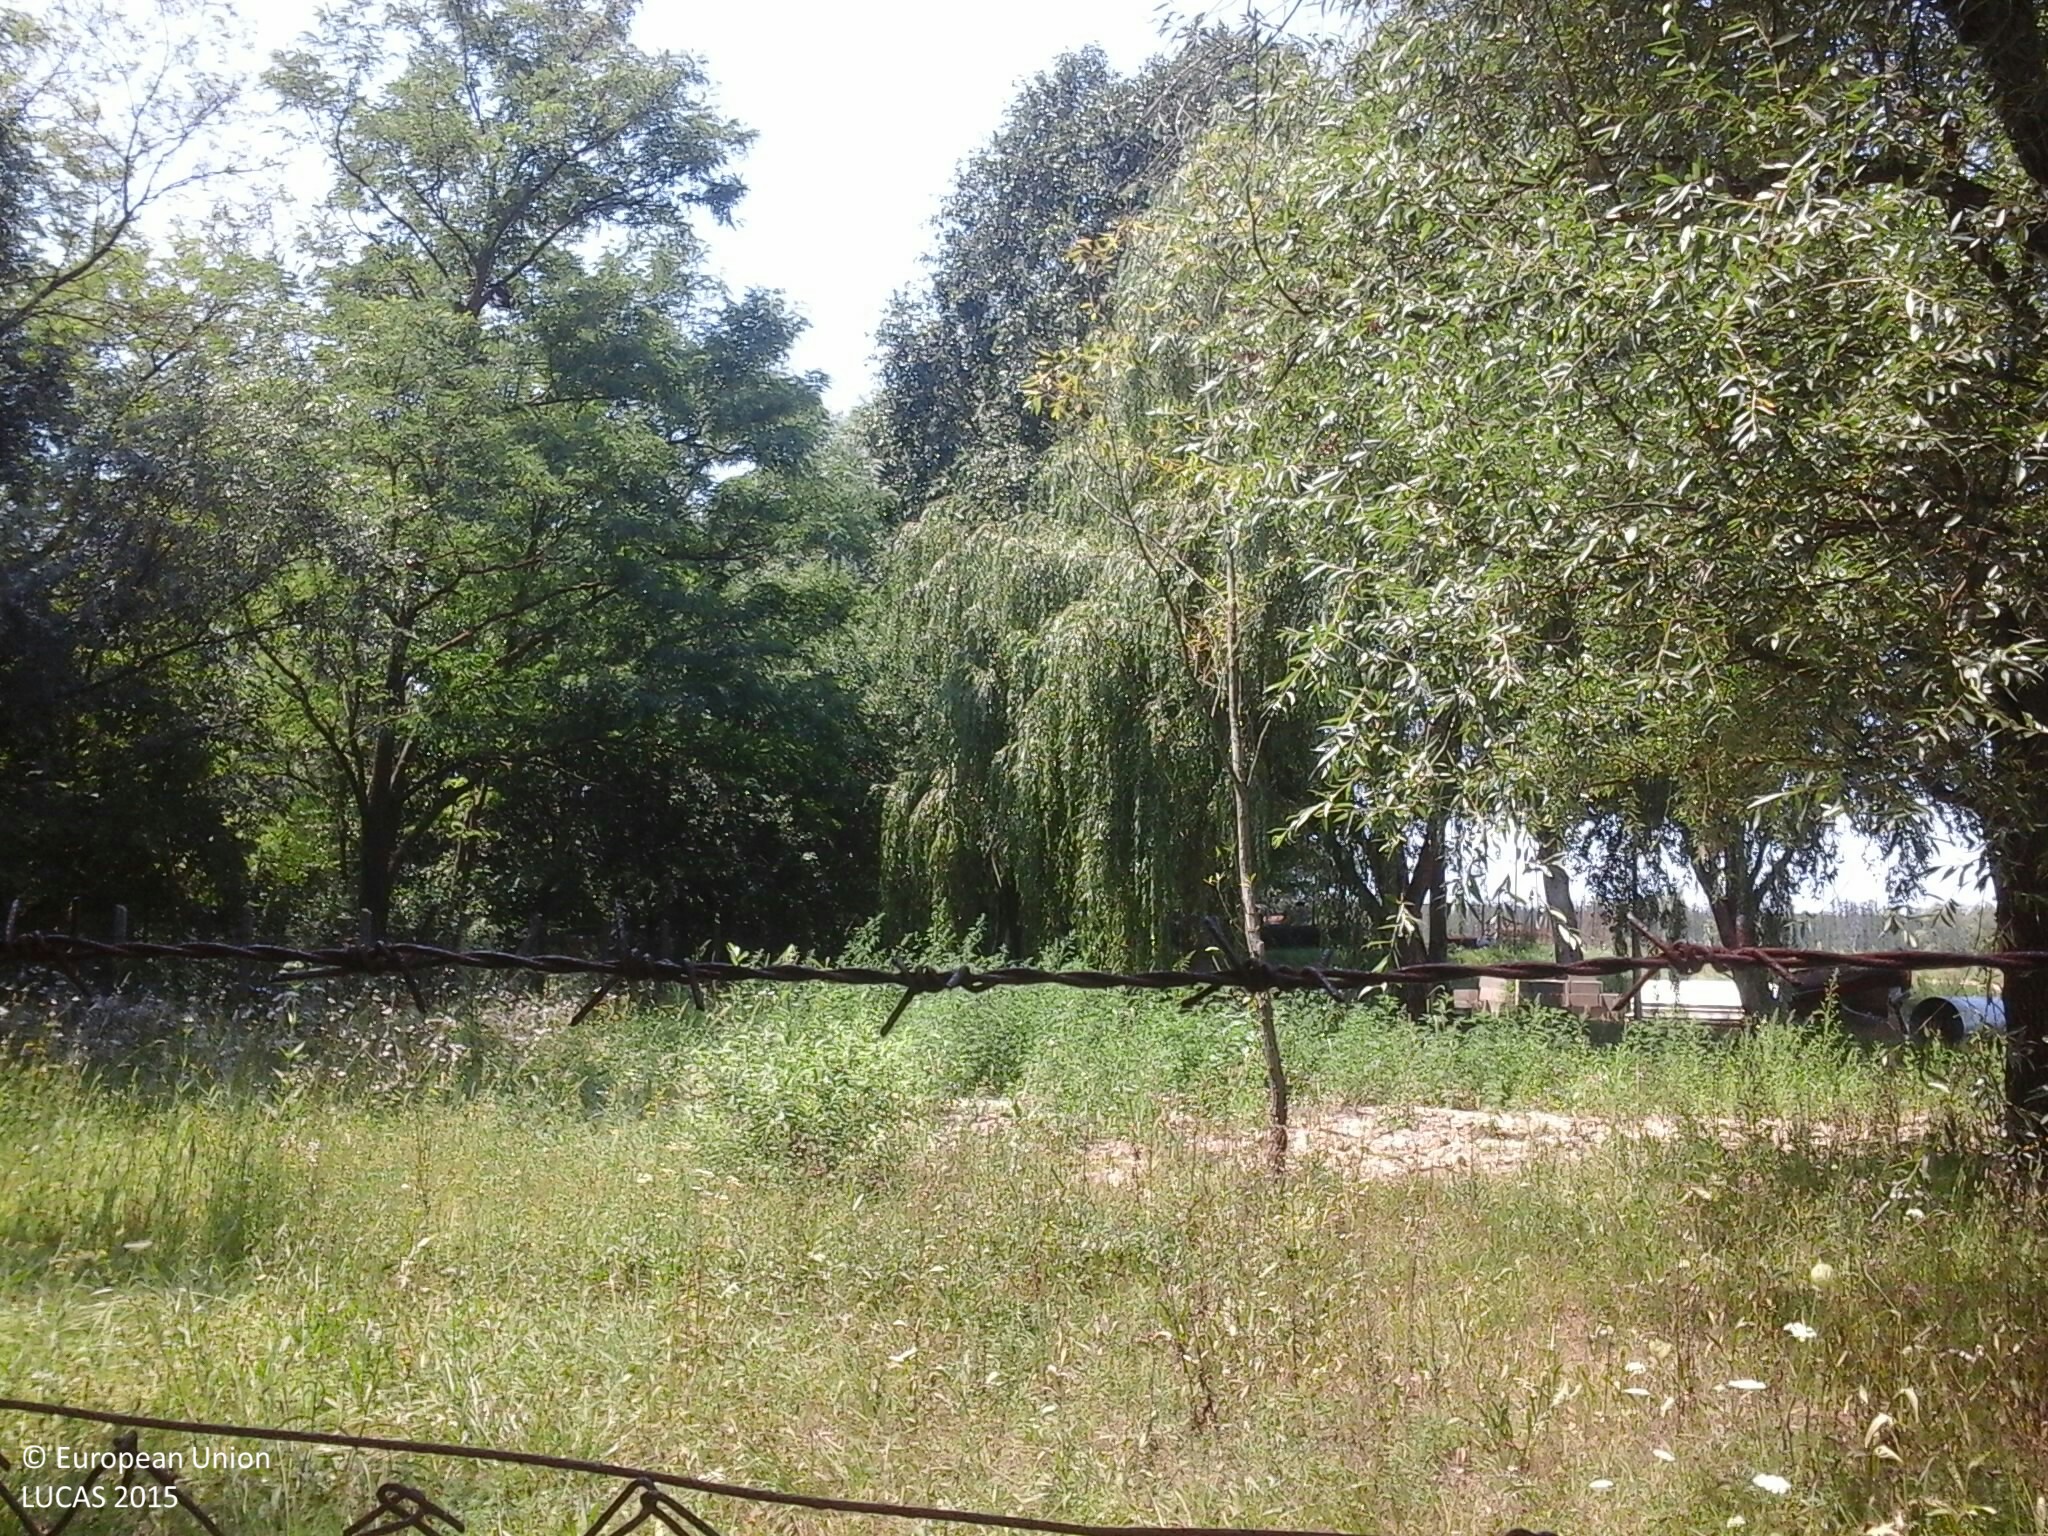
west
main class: Woodland
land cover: Broadleaved woodland
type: mesophytic deciduous forest
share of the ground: 50 - 75 %
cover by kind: broadleaved forest trees 50 %, herbaceous plants 50 %
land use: Residential
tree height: > 5 m
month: July
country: HU
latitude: 46.7025
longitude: 17.2370
